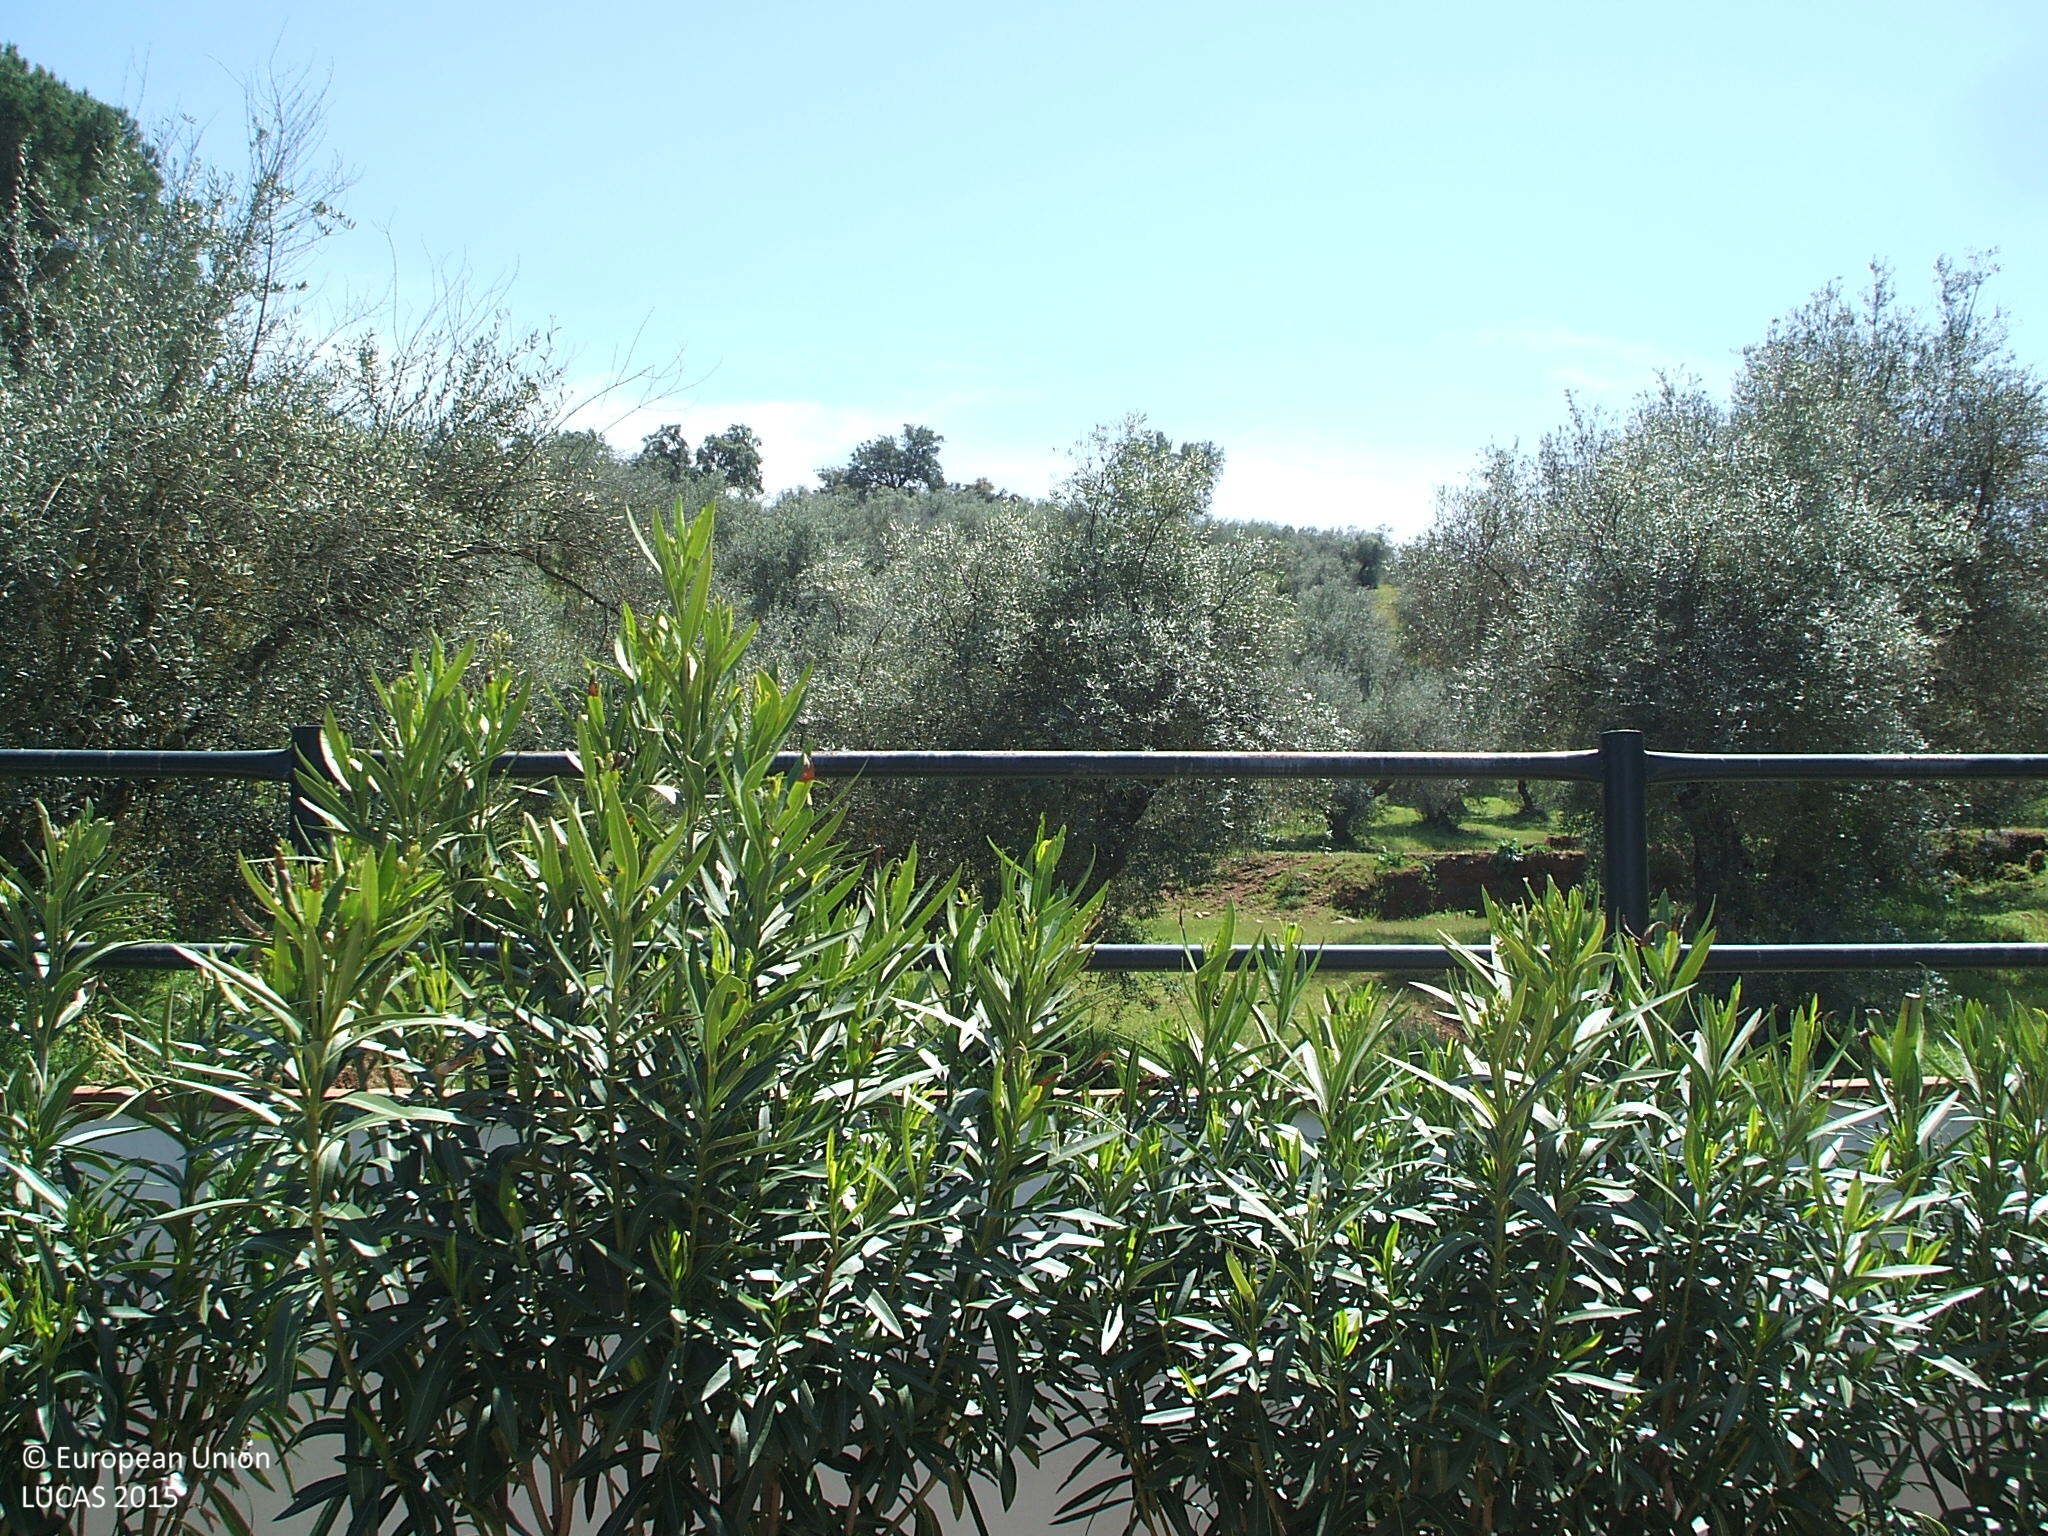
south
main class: Cropland
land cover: Olive groves
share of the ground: 50 - 75 %
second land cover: Grassland without tree/shrub cover
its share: > 75 %
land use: Agriculture (excluding fallow land and kitchen gardens)
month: April
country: ES
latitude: 37.9419
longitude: -5.7210
